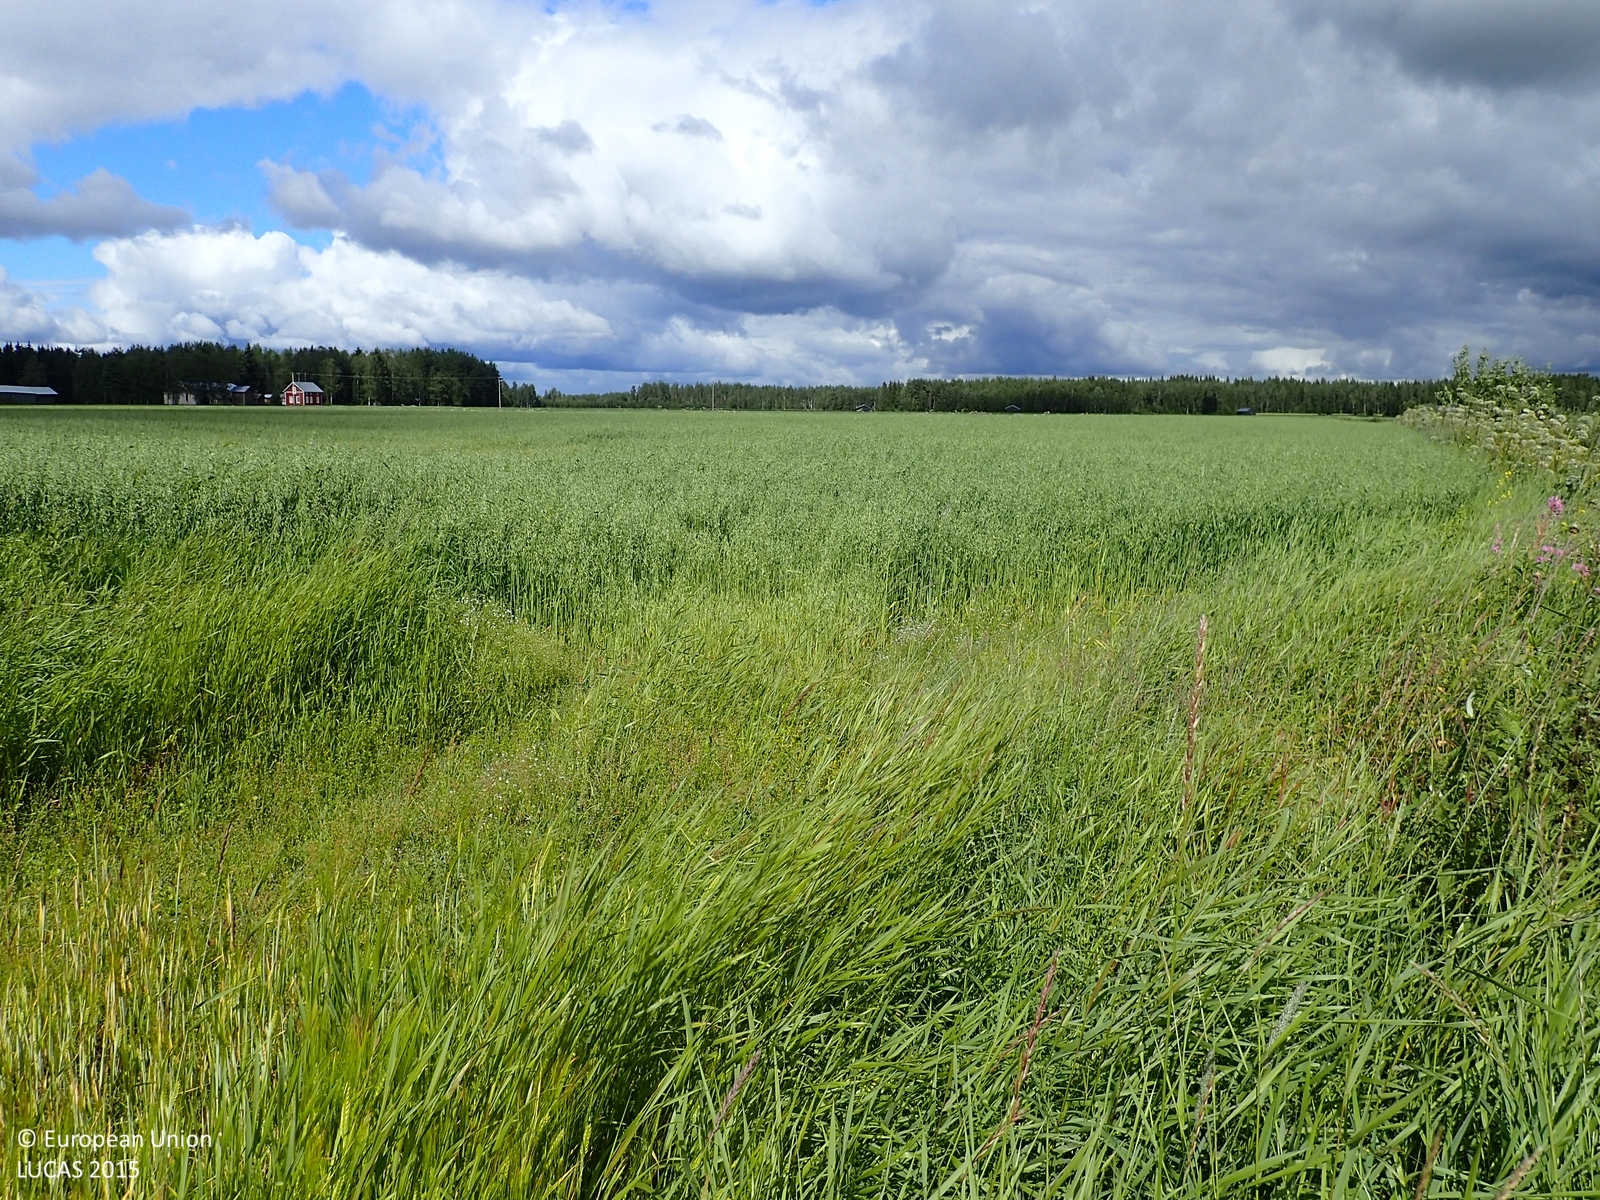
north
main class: Cropland
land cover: Barley
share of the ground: > 75 %
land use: Agriculture (excluding fallow land and kitchen gardens)
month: August
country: FI
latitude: 62.6572
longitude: 21.8134
